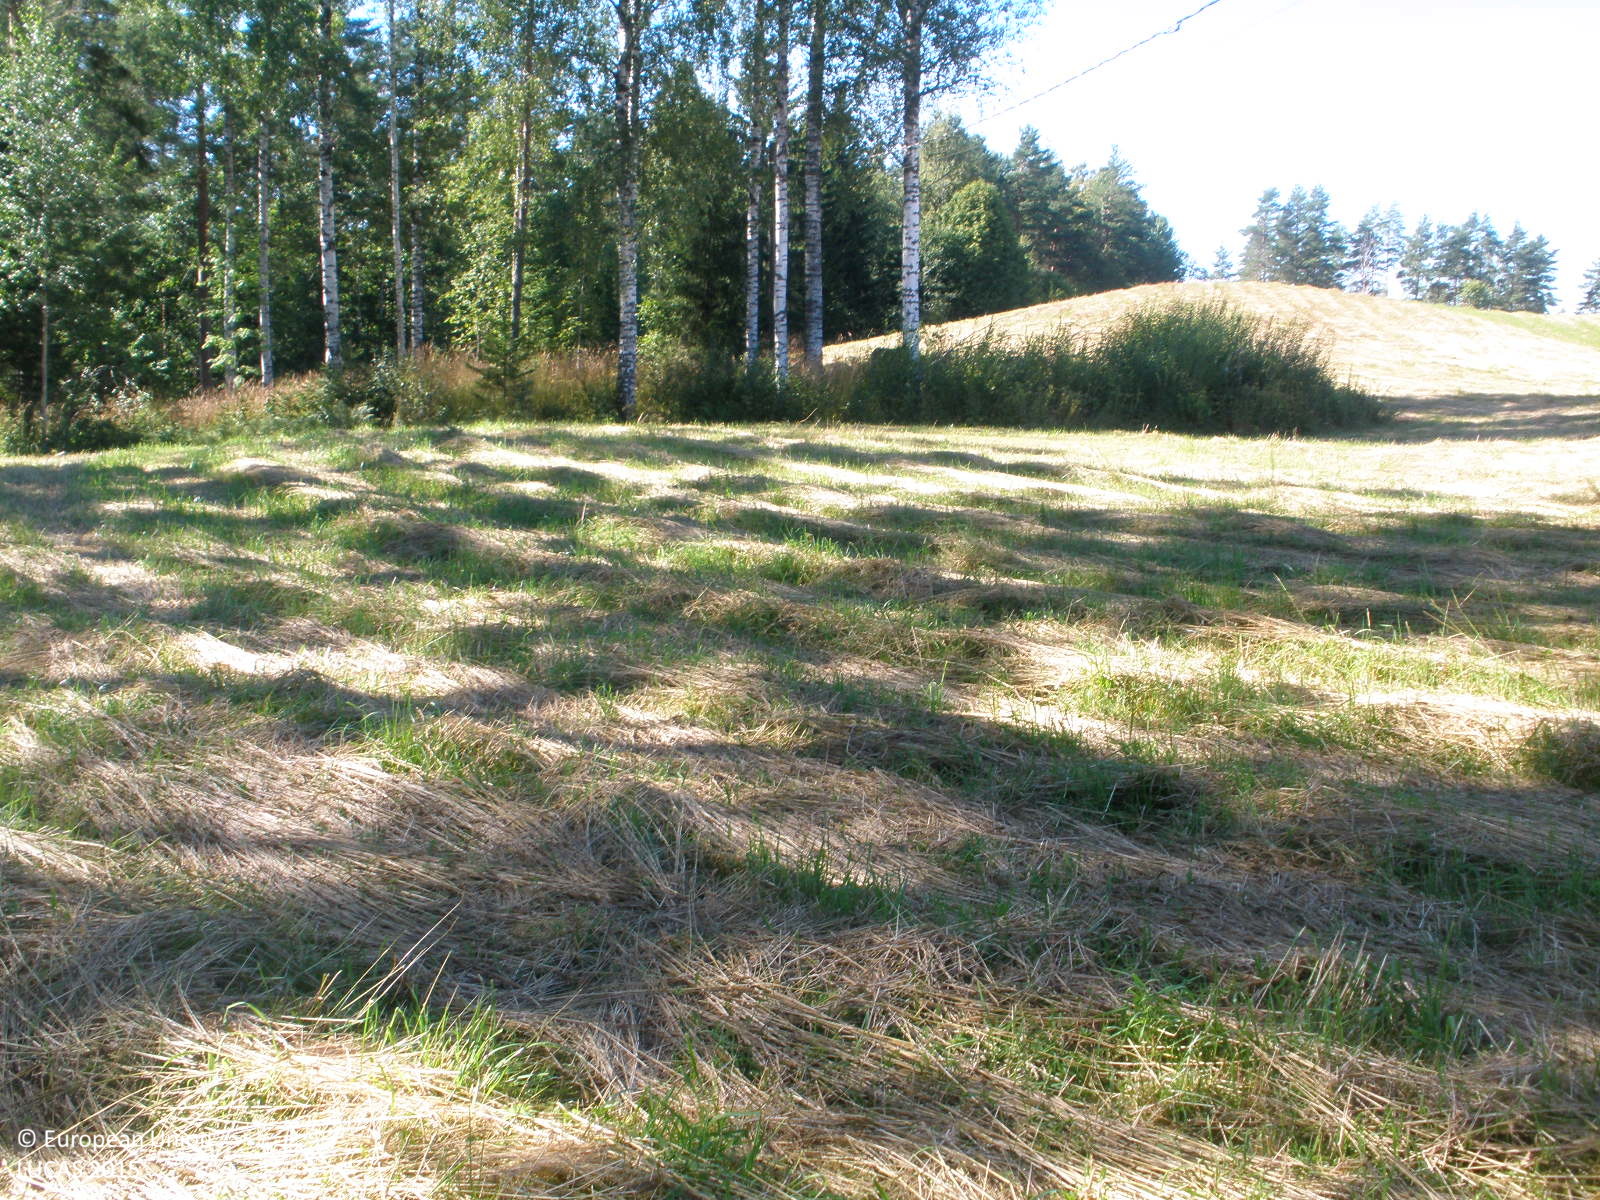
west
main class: Cropland
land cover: Mixed cereals for fodder
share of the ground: 25 - 50 %
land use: Agriculture (excluding fallow land and kitchen gardens)
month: August
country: FI
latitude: 60.6002
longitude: 23.9553
